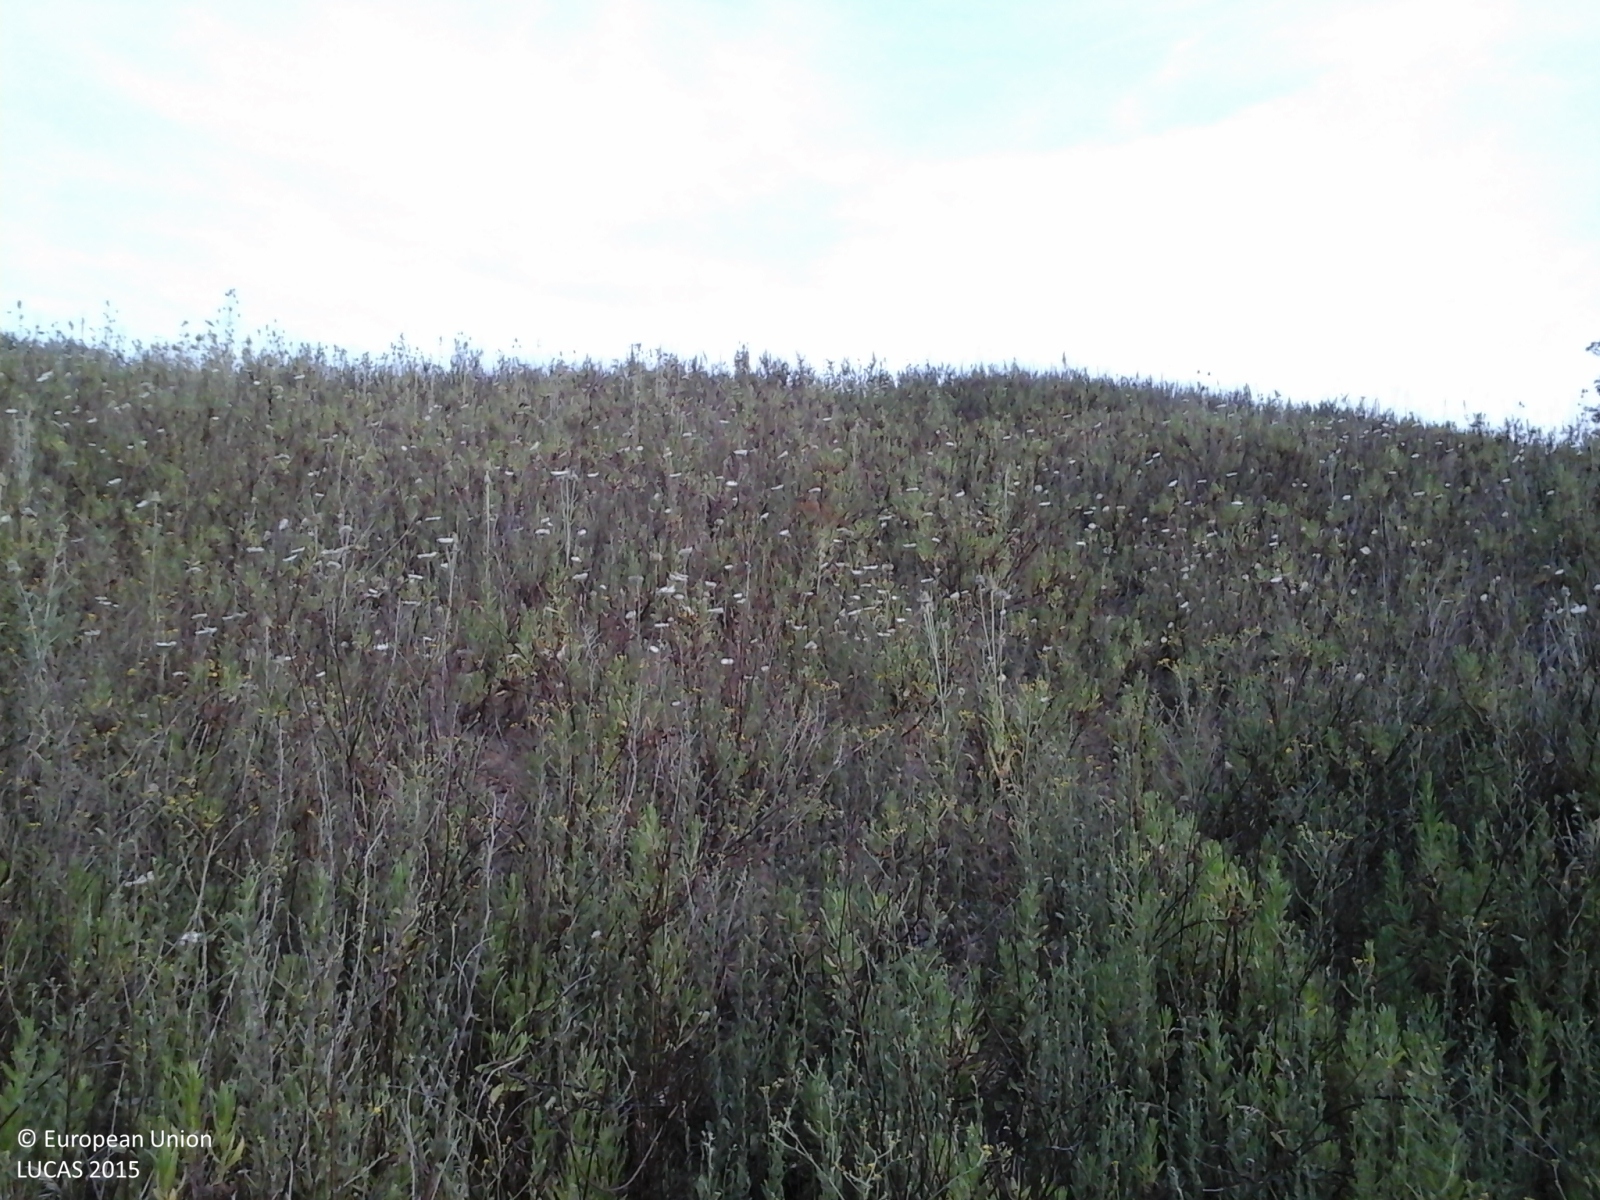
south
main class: Grassland
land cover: Spontaneously vegetated surfaces
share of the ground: > 75 %
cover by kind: herbaceous plants 95 %, unconsolidated bare surface 5 %
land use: Fallow land
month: July
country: IT
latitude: 42.8633
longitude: 11.2323
